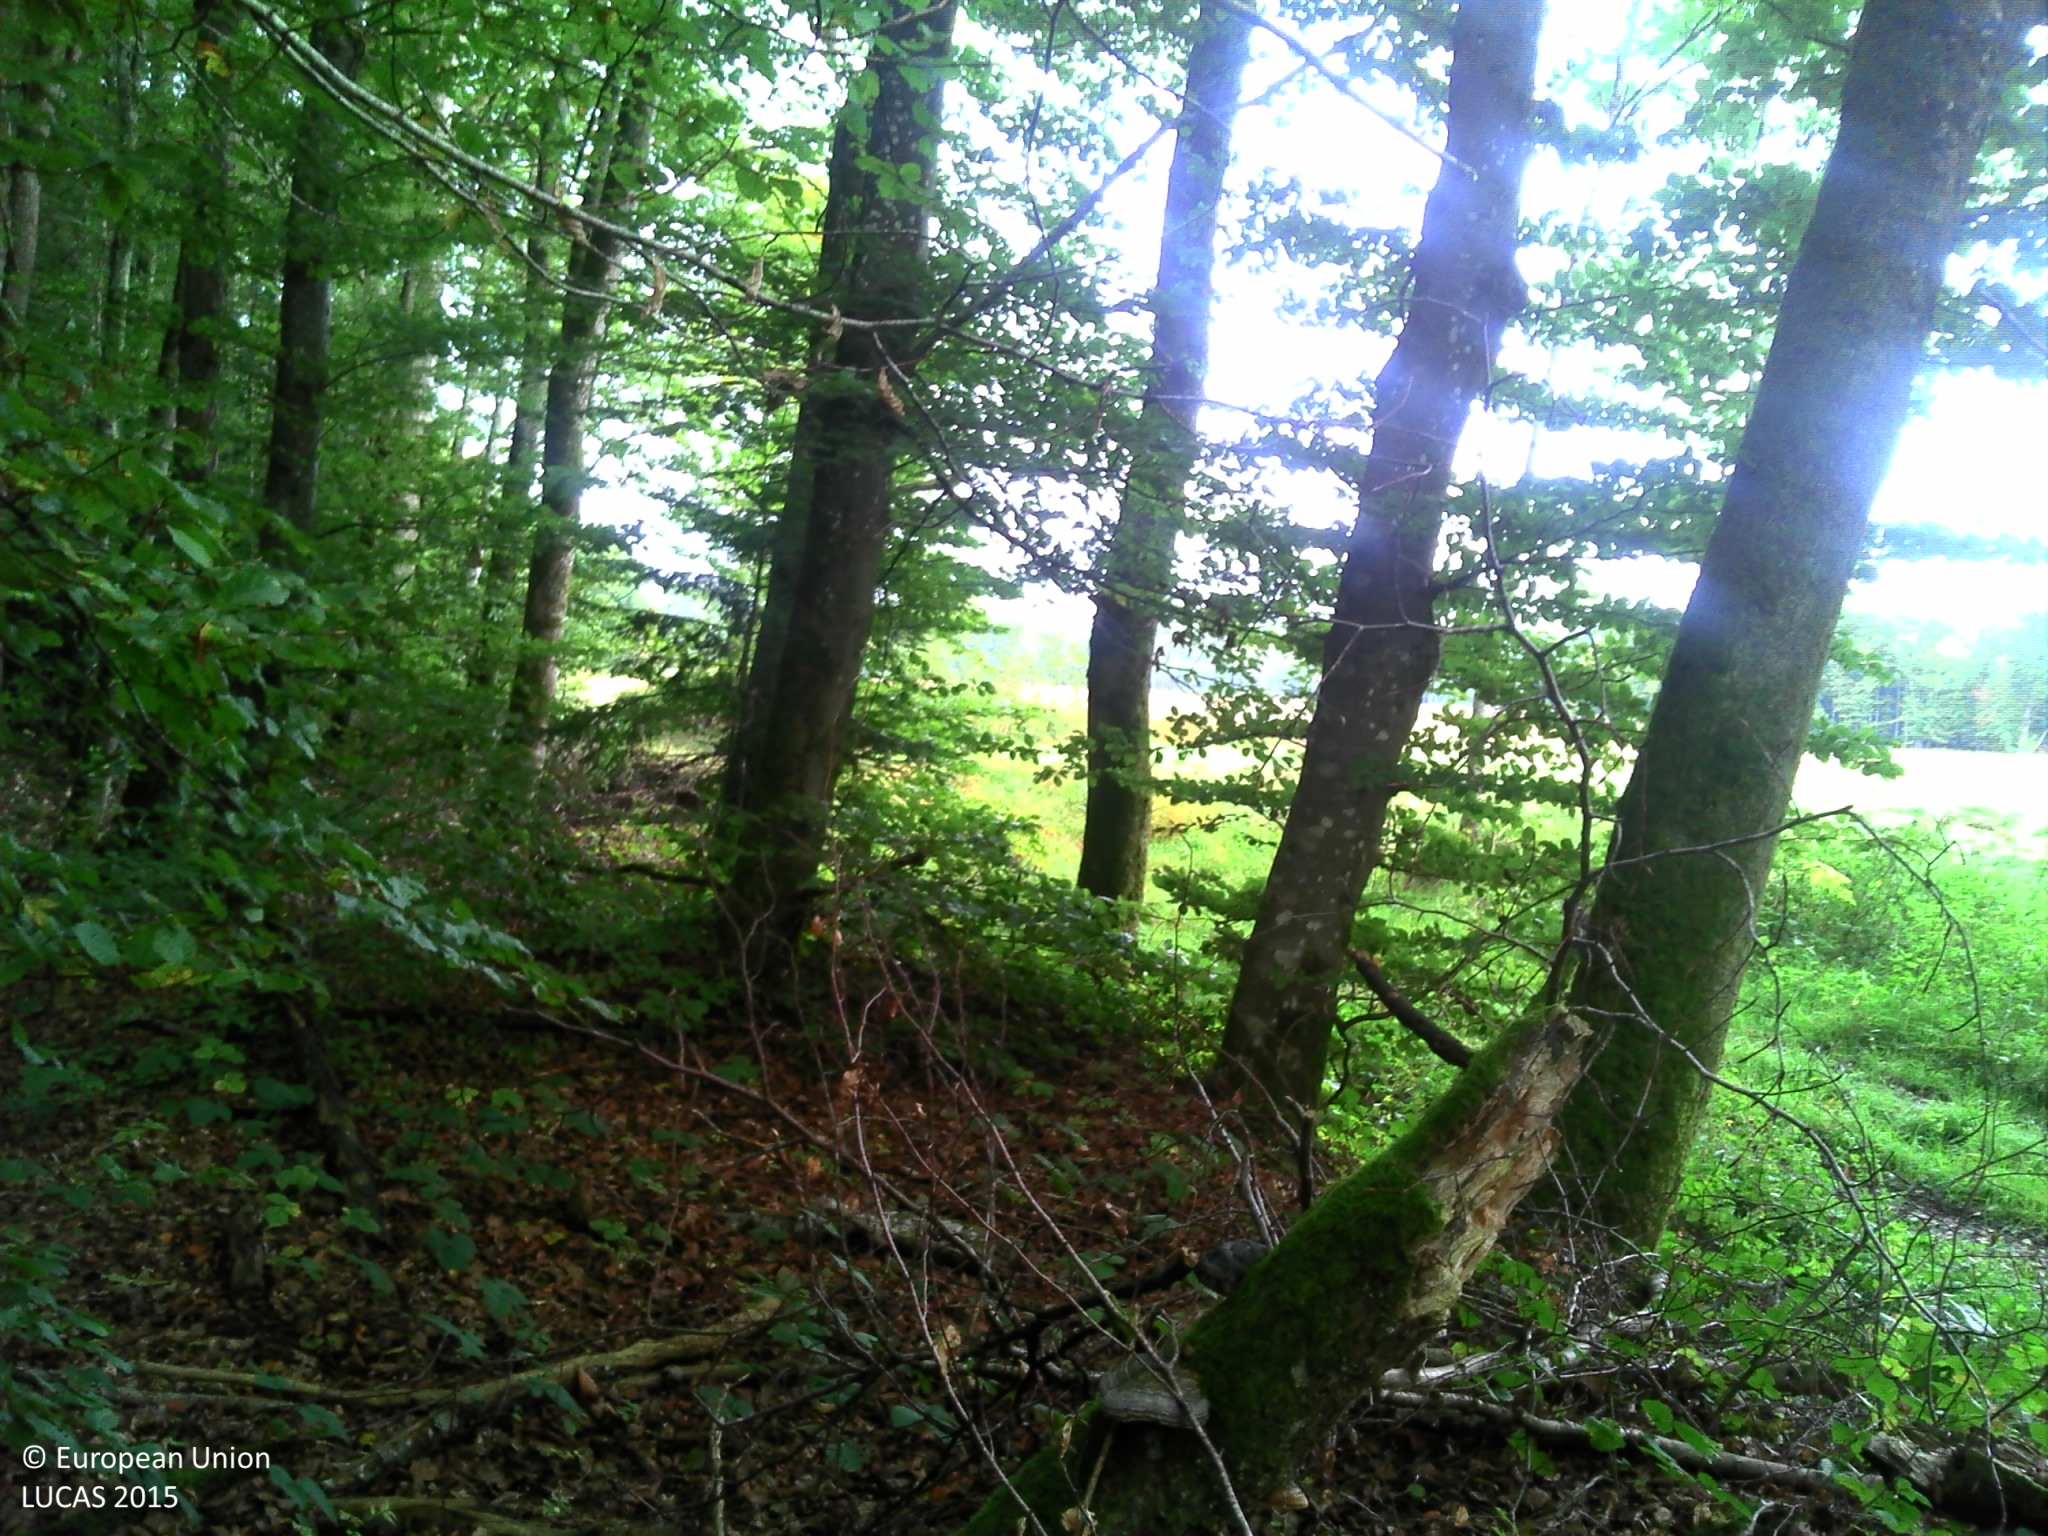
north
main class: Woodland
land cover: Other mixed woodland
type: hemiboreal forest and nemoral coniferous forest and mixed broadleaved-coniferous forest
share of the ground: > 75 %
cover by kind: broadleaved forest trees 45 %, coniferous forest trees 40 %, consolidated bare surface 10 %, herbaceous plants 5 %
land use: Forestry
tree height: > 5 m
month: September
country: FR
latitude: 48.4659
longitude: 6.8224
